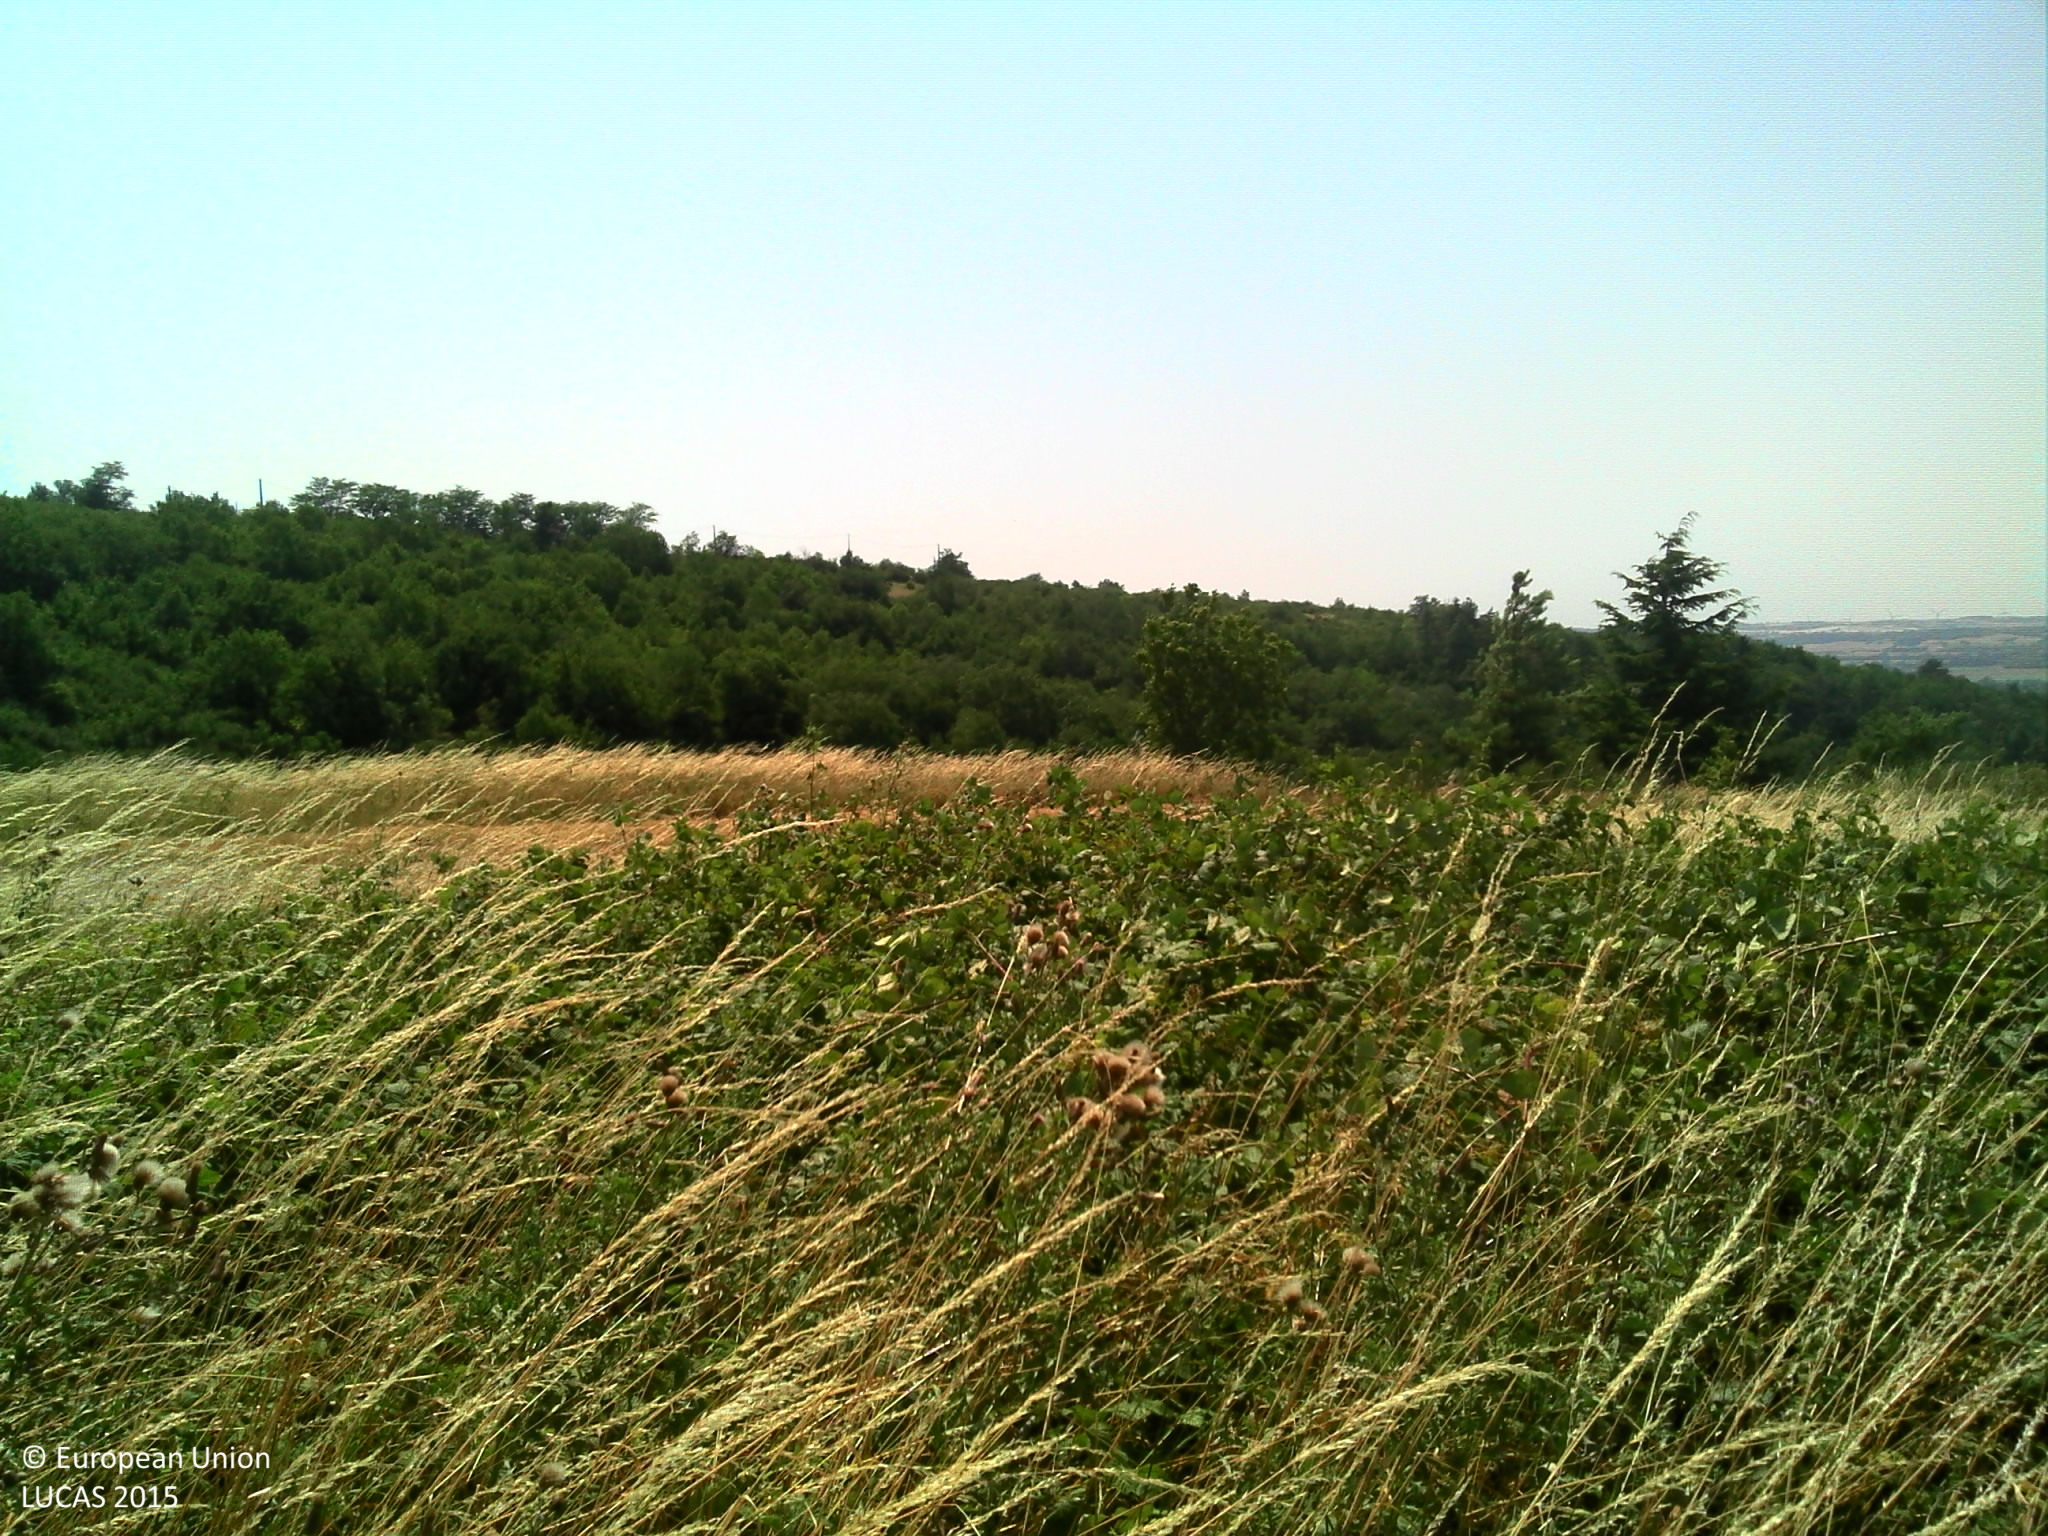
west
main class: Shrubland
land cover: Shrubland with sparse tree cover
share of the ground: > 75 %
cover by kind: shrubs 65 %, herbaceous plants 30 %, broadleaved forest trees 5 %
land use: Semi-natural and natural areas not in use
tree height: < 5 m
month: July
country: FR
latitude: 43.4442
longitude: 2.0114
